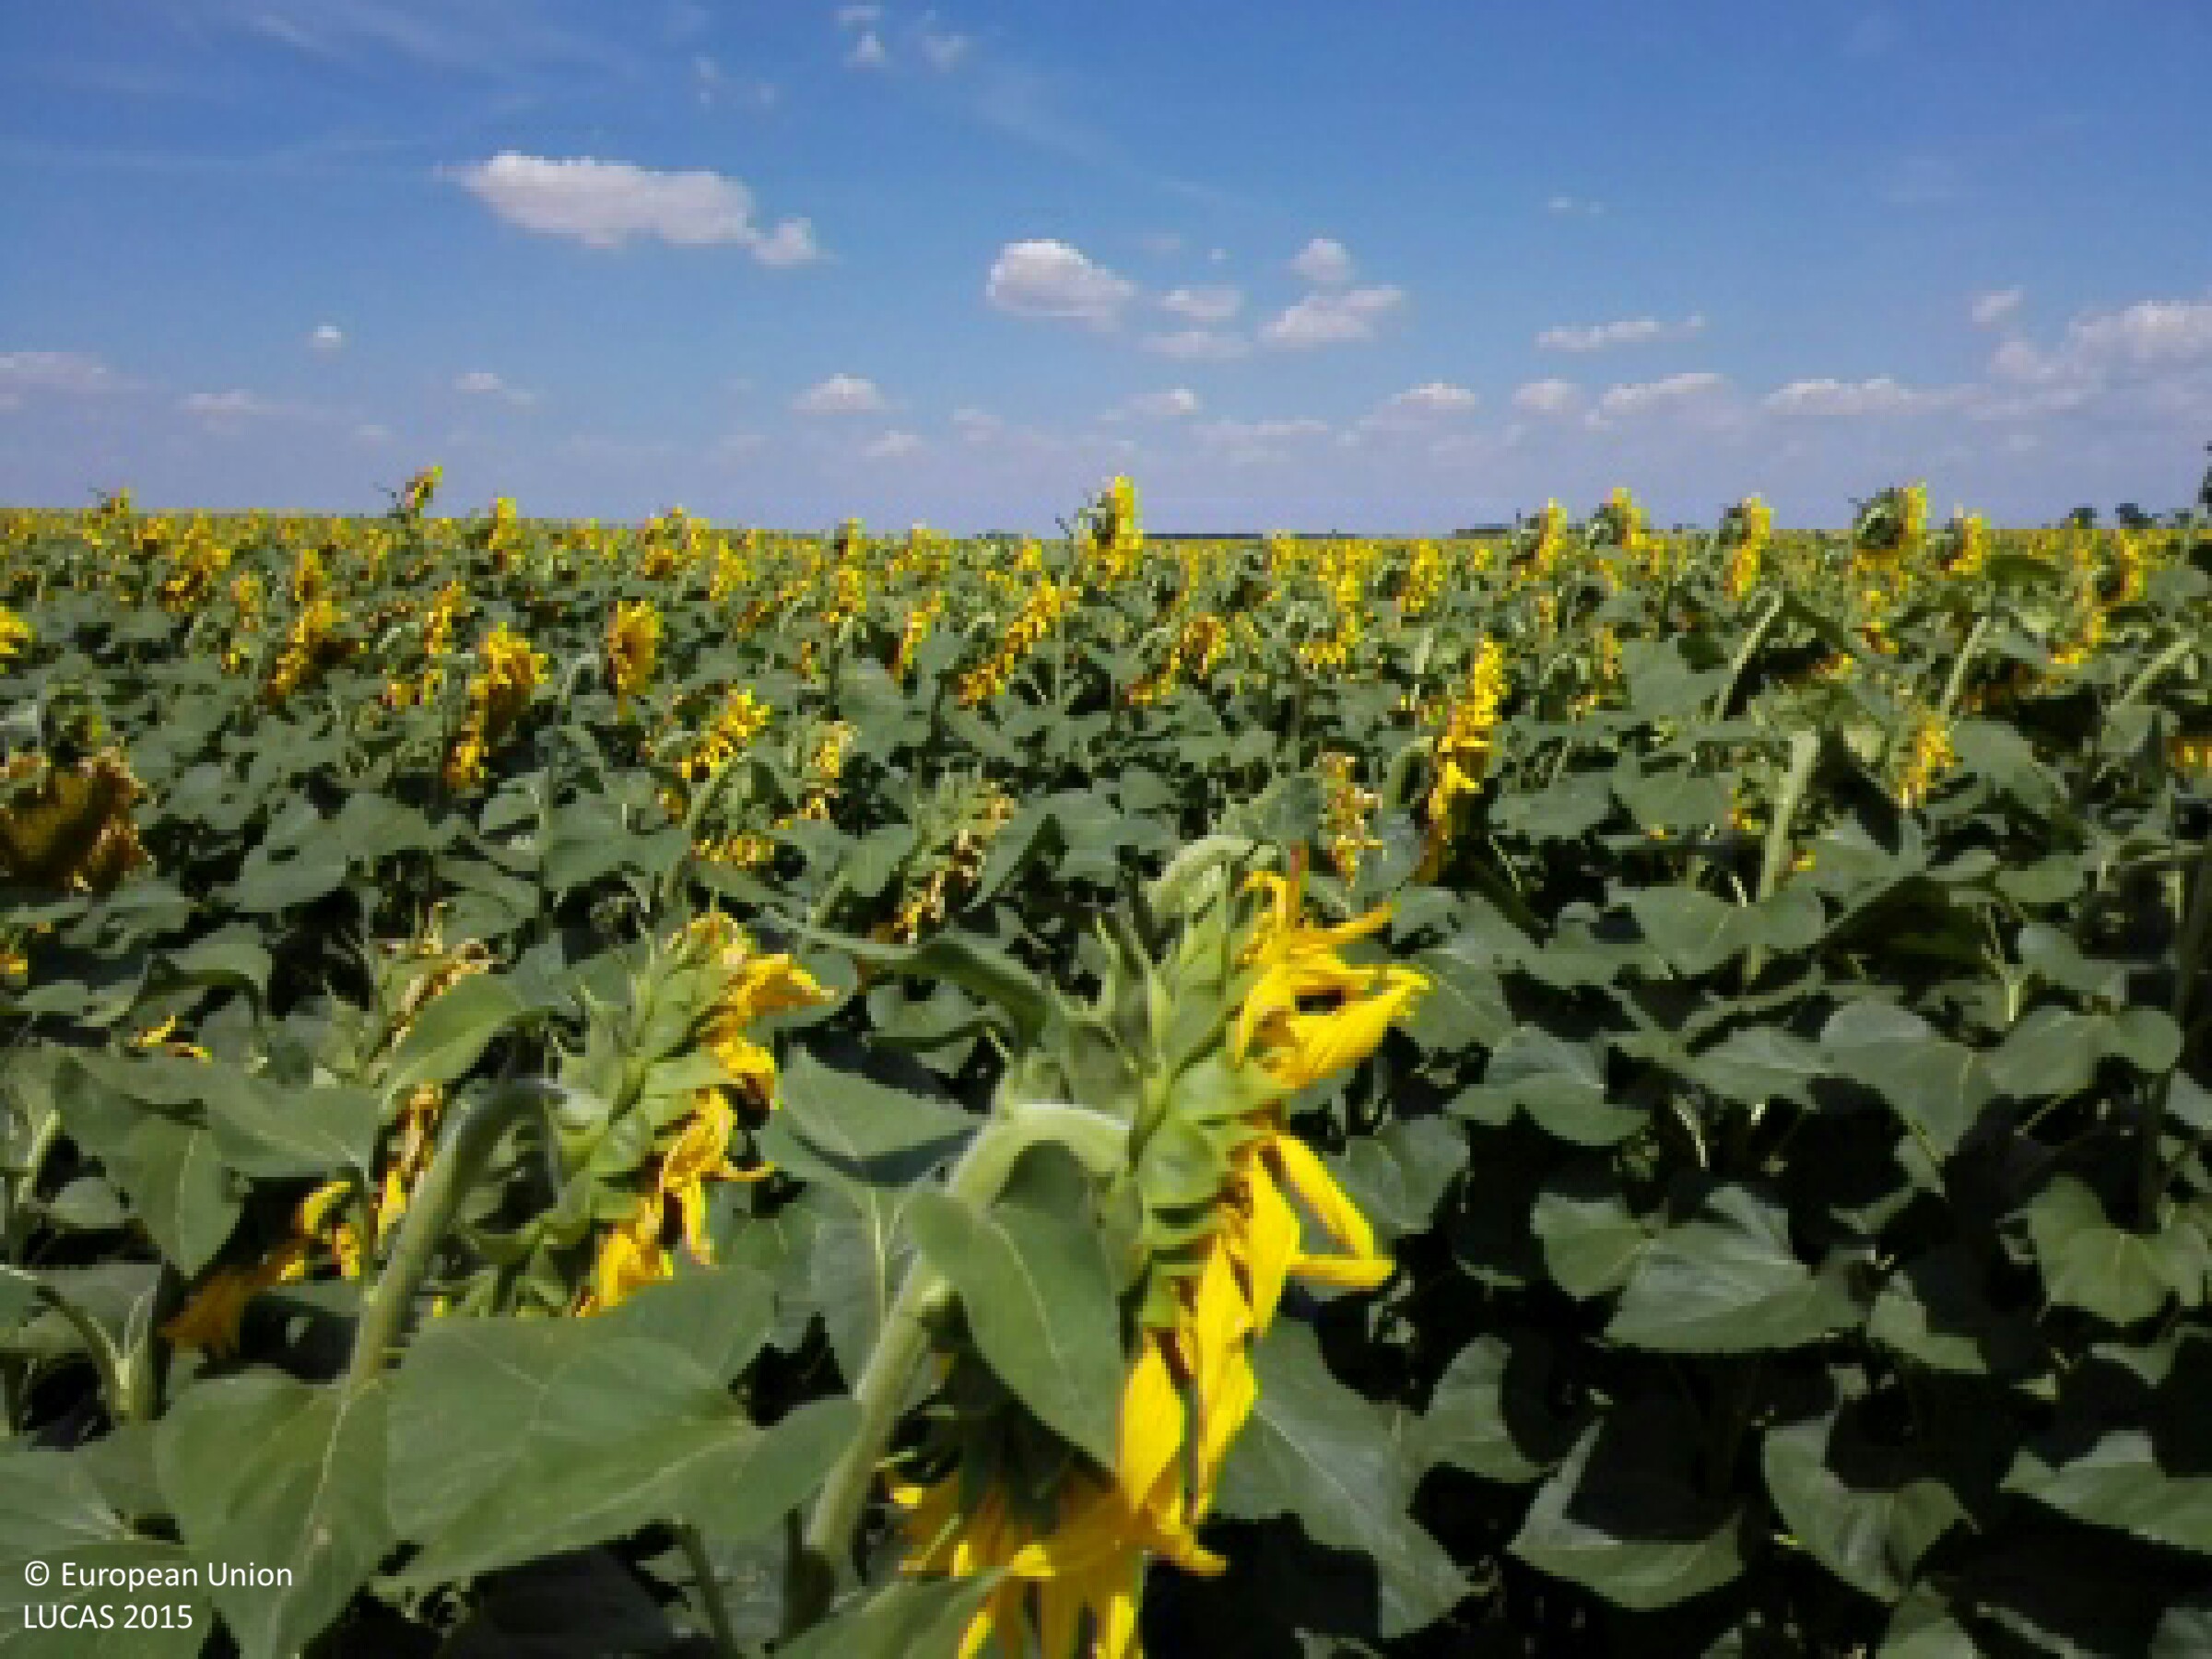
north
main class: Cropland
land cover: Sunflower
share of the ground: > 75 %
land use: Agriculture (excluding fallow land and kitchen gardens)
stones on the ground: < 10 %
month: July
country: HU
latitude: 47.4203
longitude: 21.3204
